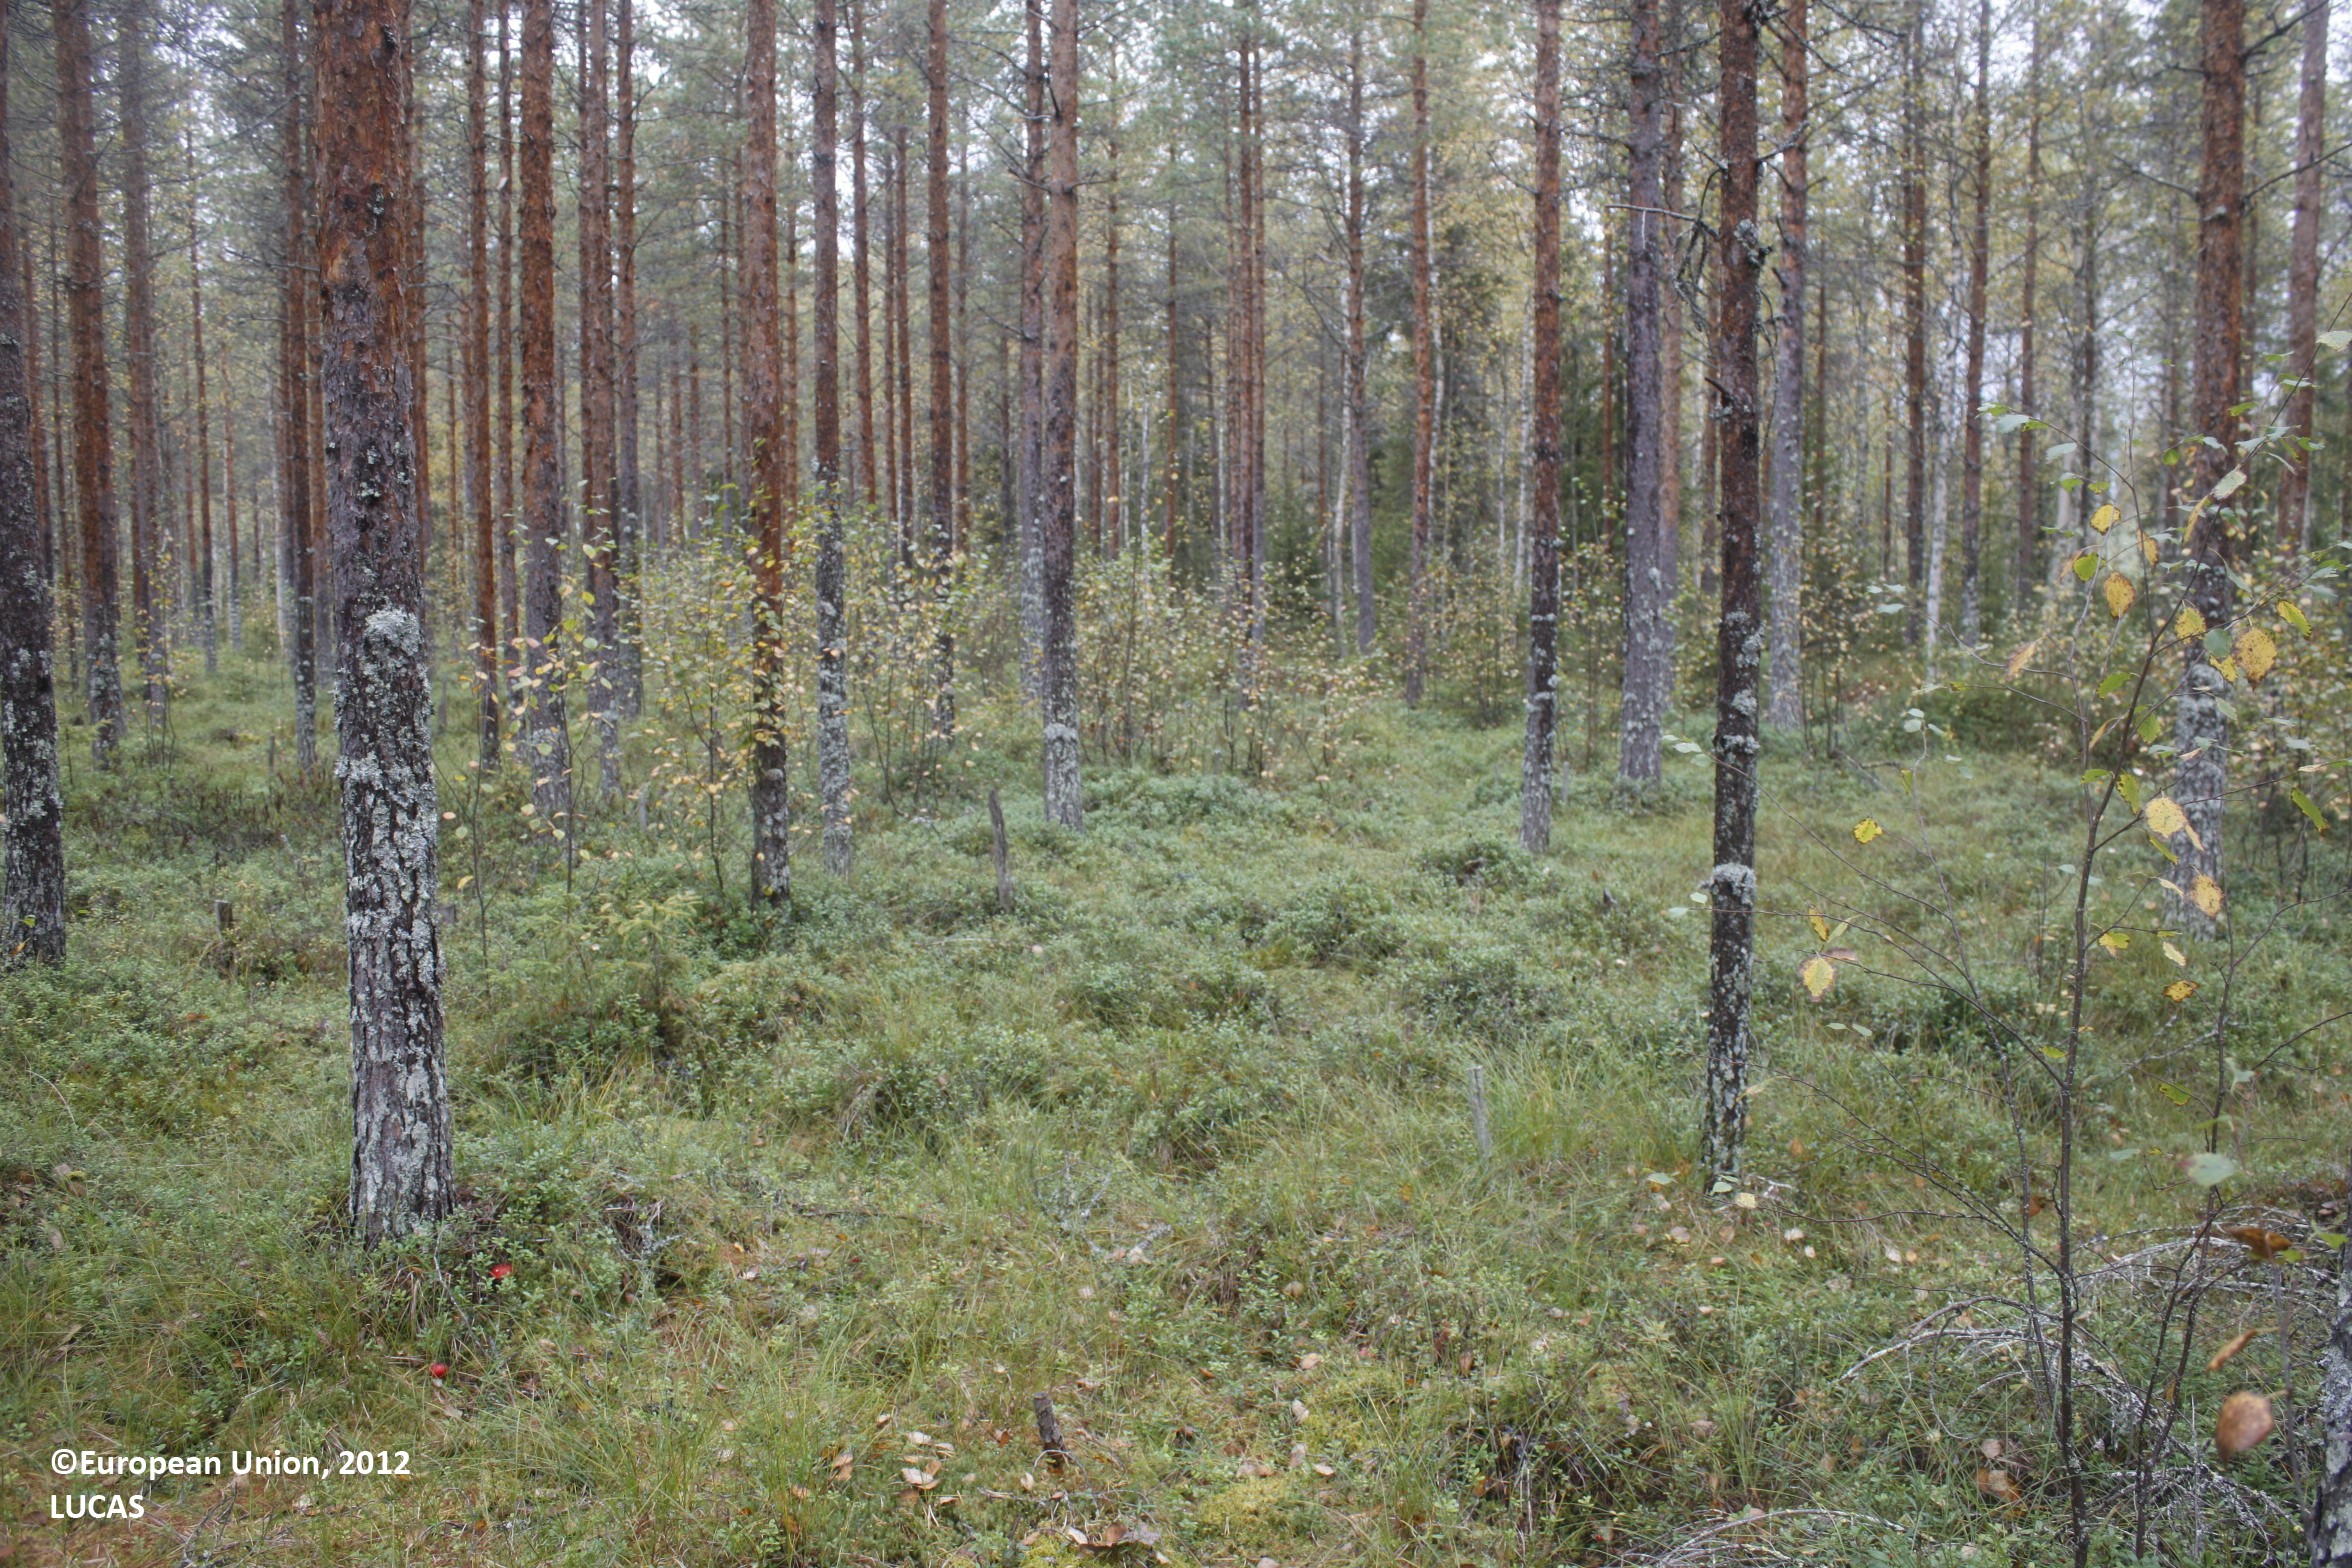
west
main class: Woodland
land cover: Pine dominated coniferous woodland
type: boreal forest
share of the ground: 50 - 75 %
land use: Forestry
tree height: > 5 m
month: September
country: FI
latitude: 65.1050
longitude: 26.6532
